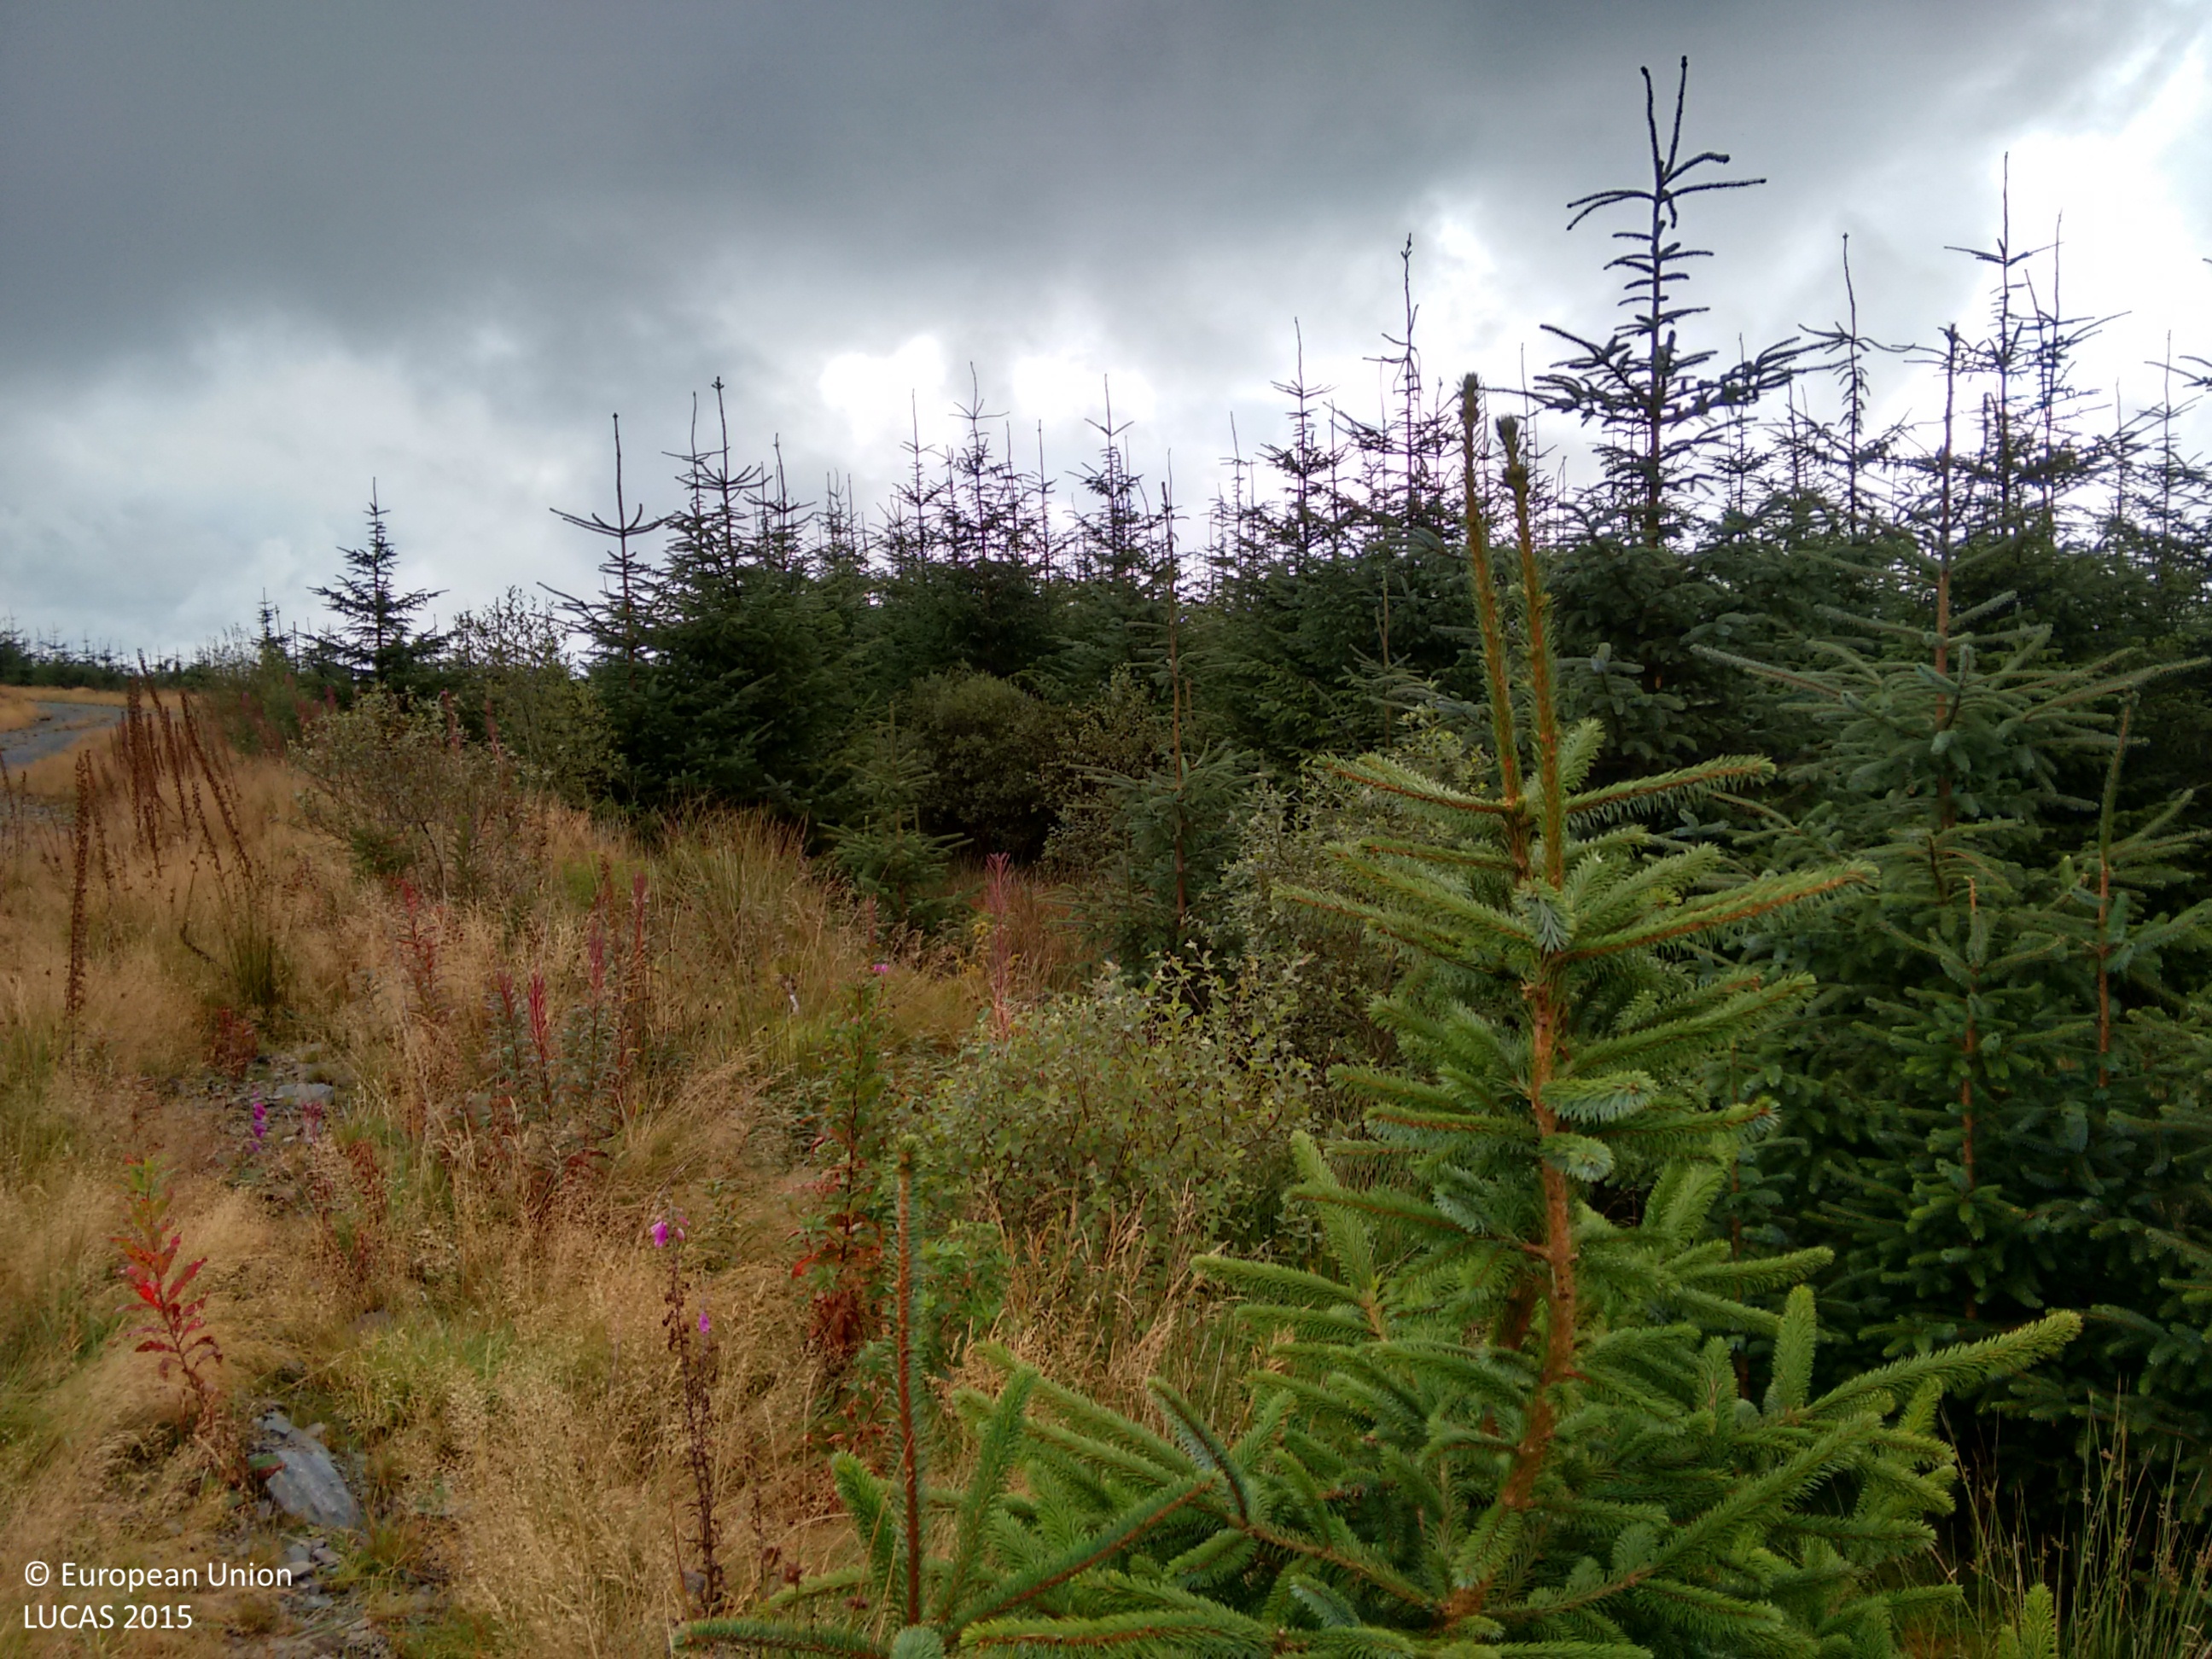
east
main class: Woodland
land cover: Spruce dominated coniferous woodland
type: exotic forest
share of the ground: > 75 %
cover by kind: coniferous forest trees 70 %, herbaceous plants 30 %
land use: Forestry
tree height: < 5 m
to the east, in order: Spruce dominated coniferous woodland
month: September
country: GB
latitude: 52.1589
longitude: -3.7273
